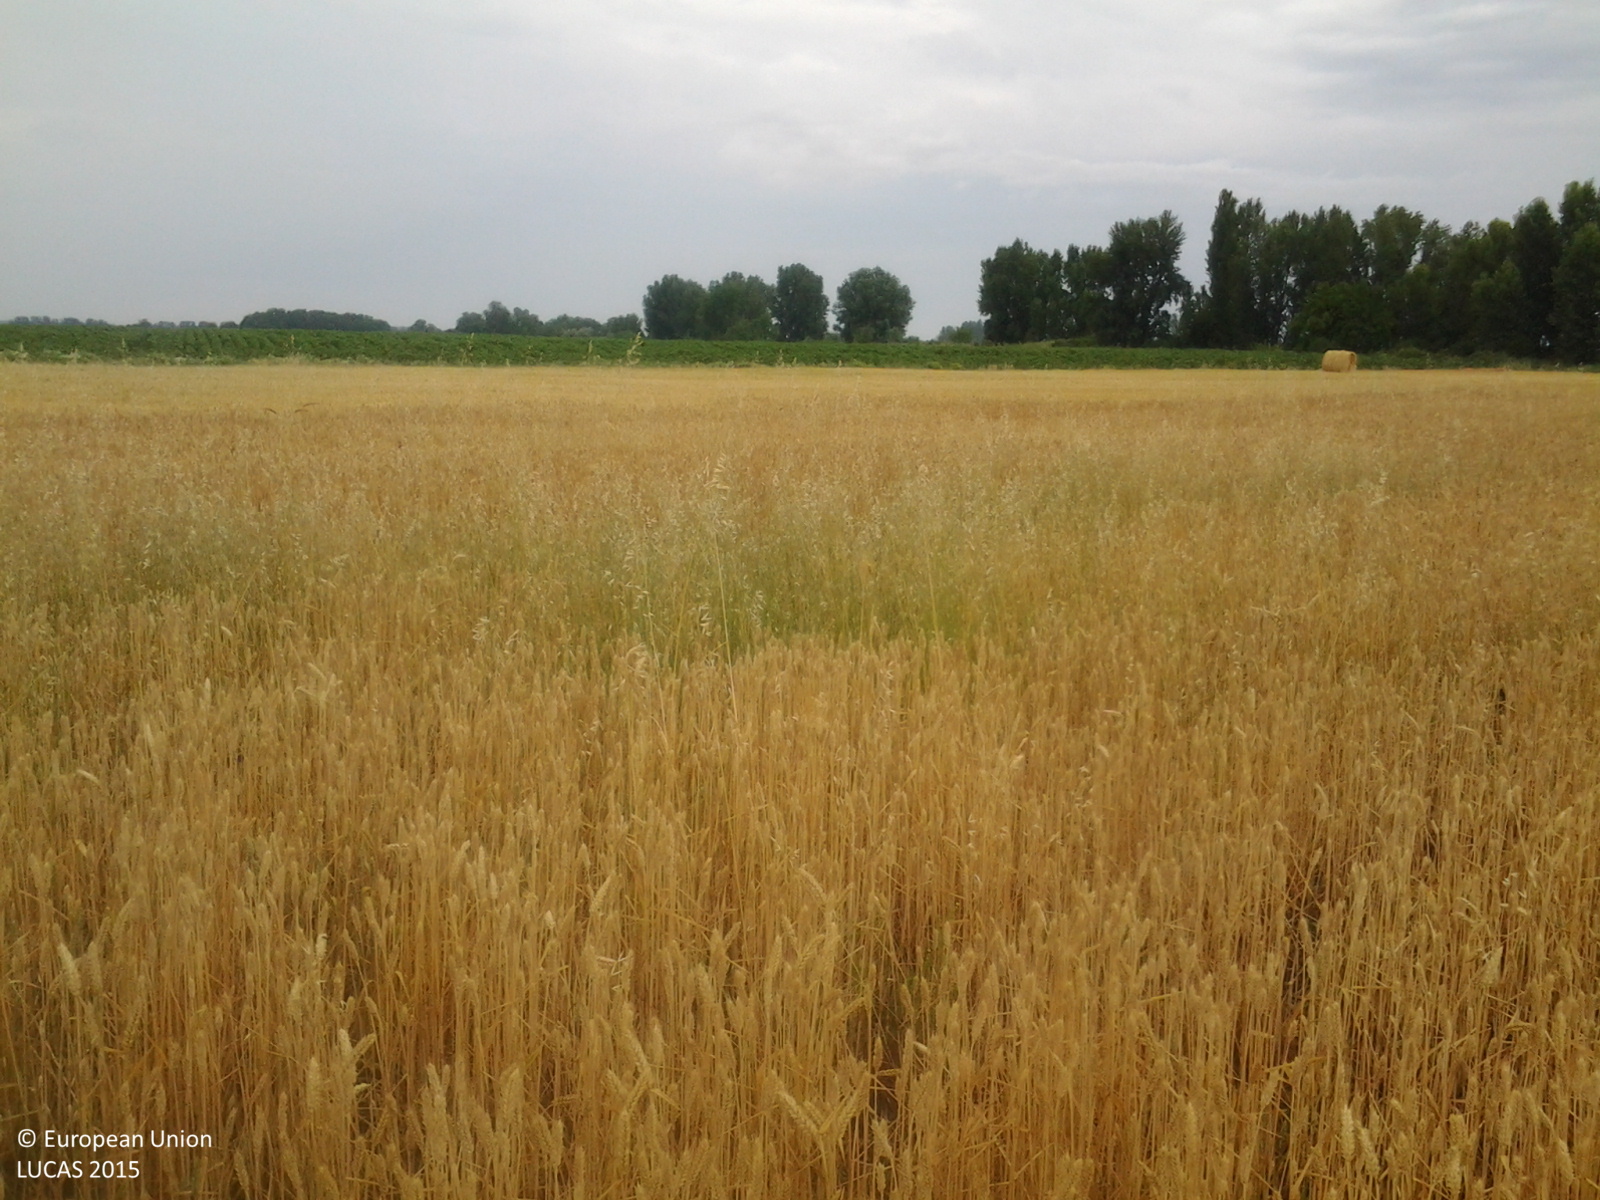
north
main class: Cropland
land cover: Common wheat
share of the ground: > 75 %
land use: Agriculture (excluding fallow land and kitchen gardens)
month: June
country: HU
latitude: 46.8566
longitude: 20.4286
